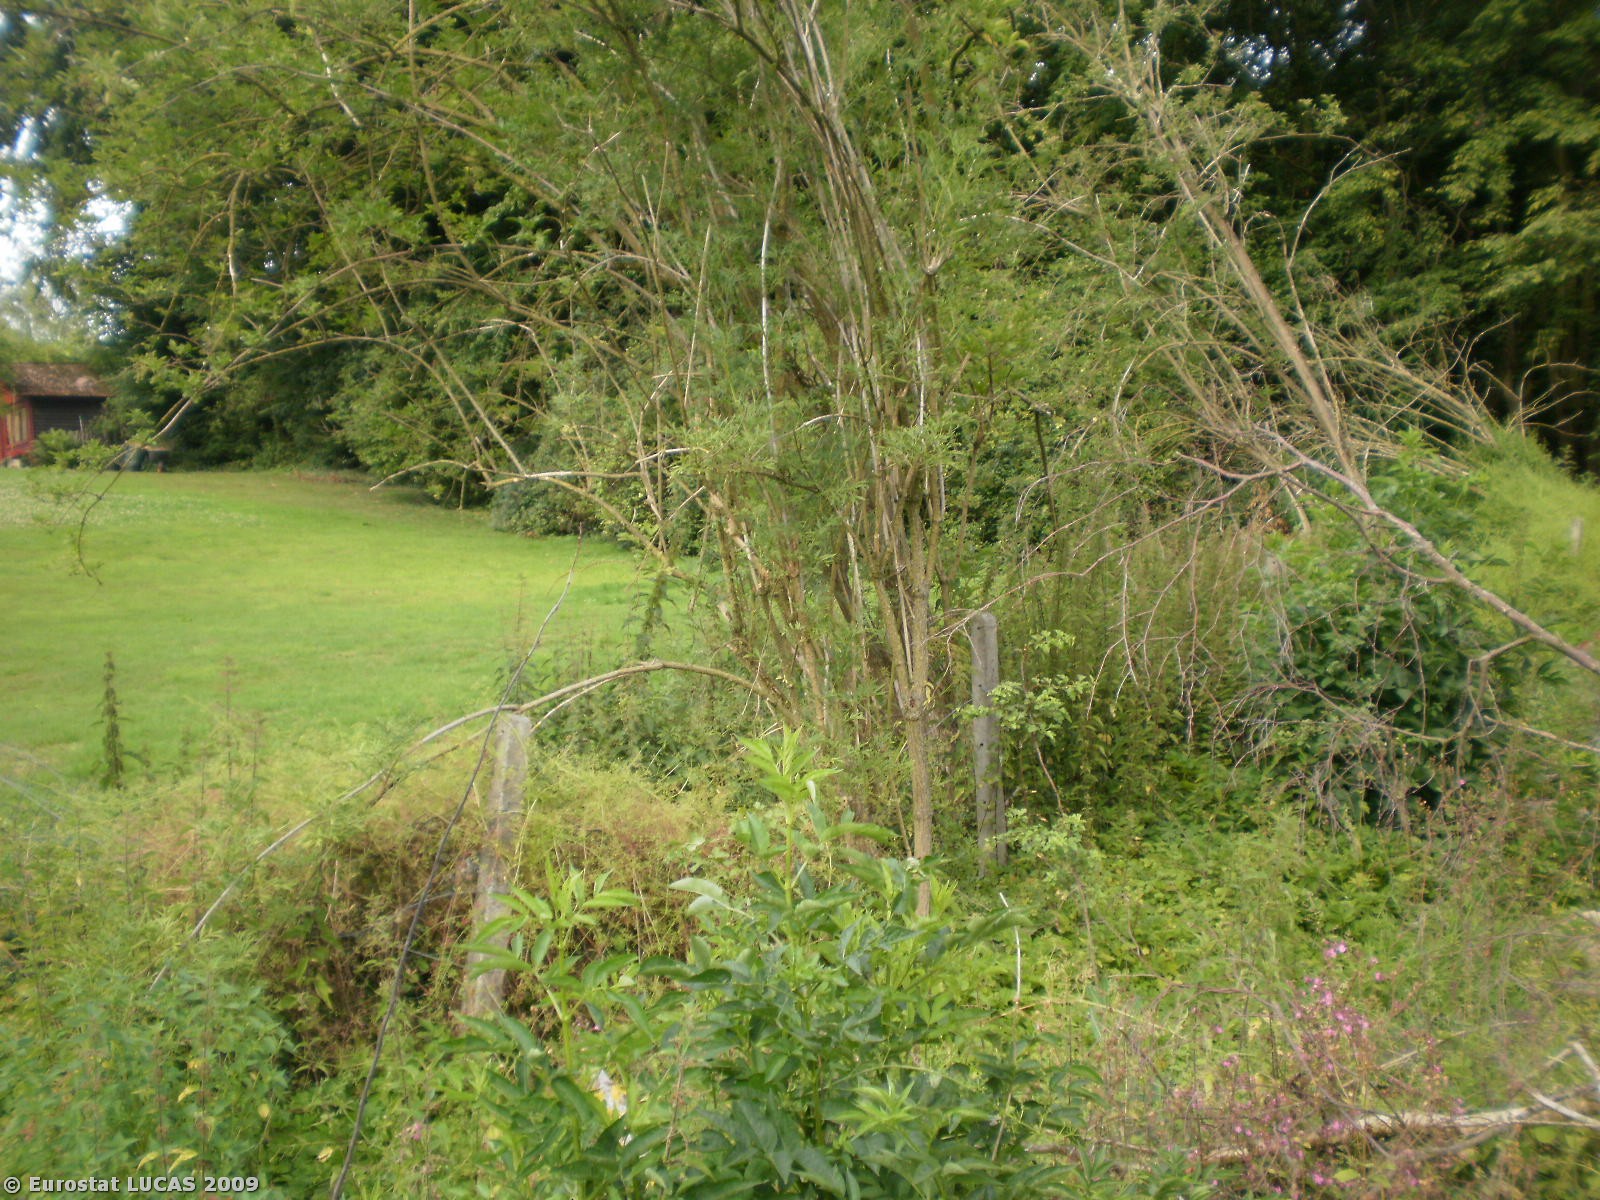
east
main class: Woodland
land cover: Broadleaved woodland
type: acidophilous oak and oak-birch forest
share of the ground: > 75 %
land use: Forestry
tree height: > 5 m
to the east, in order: Broadleaved woodland; Paved roads, cycling and walking lanes; Broadleaved woodland; Grassland without tree/shrub cover; Fences; Artificial constructions in urban areas; Grassland without tree/shrub cover; Paved roads, cycling and walking lanes; Grassland without tree/shrub cover; Tracks; Artificial constructions in urban areas
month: July
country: BE
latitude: 50.9009
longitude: 4.1790
